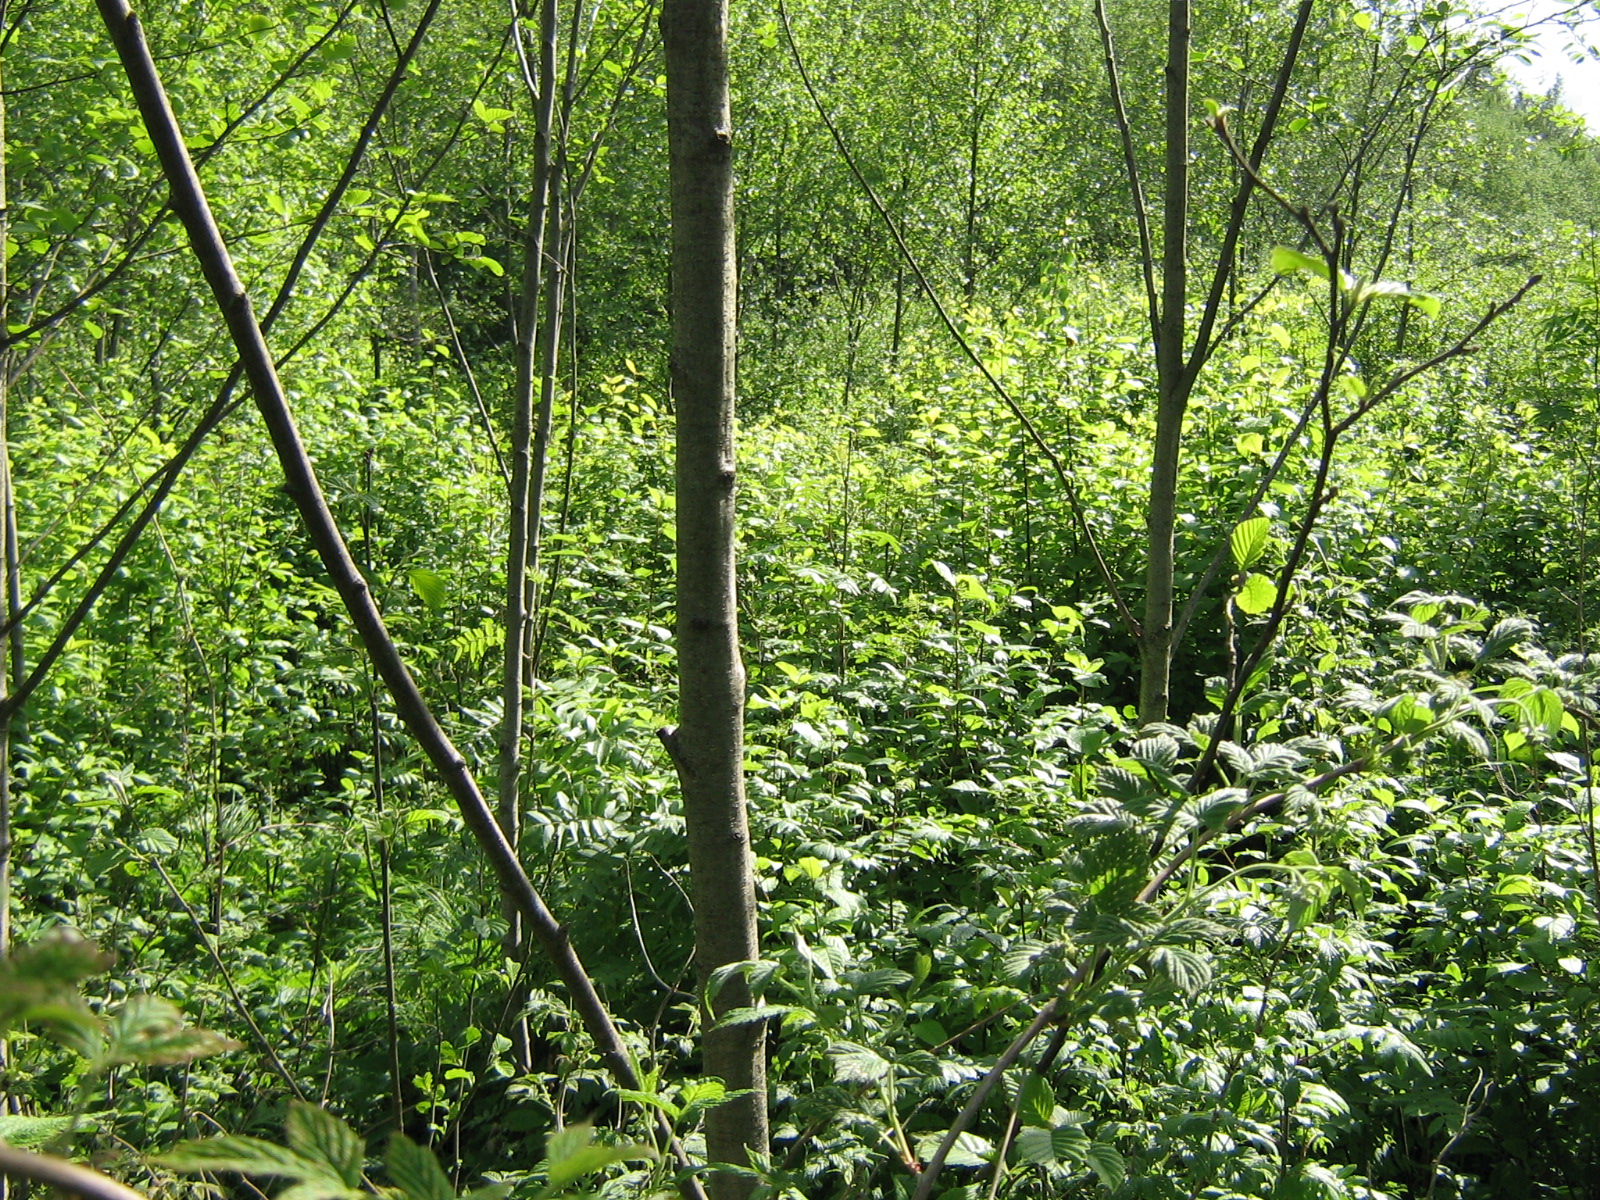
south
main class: Woodland
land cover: Broadleaved woodland
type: non-riverine alder, birch or aspen forest
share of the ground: > 75 %
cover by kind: broadleaved forest trees 100 %
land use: Forestry
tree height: < 5 m
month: June
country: LV
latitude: 57.0177
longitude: 25.3490
